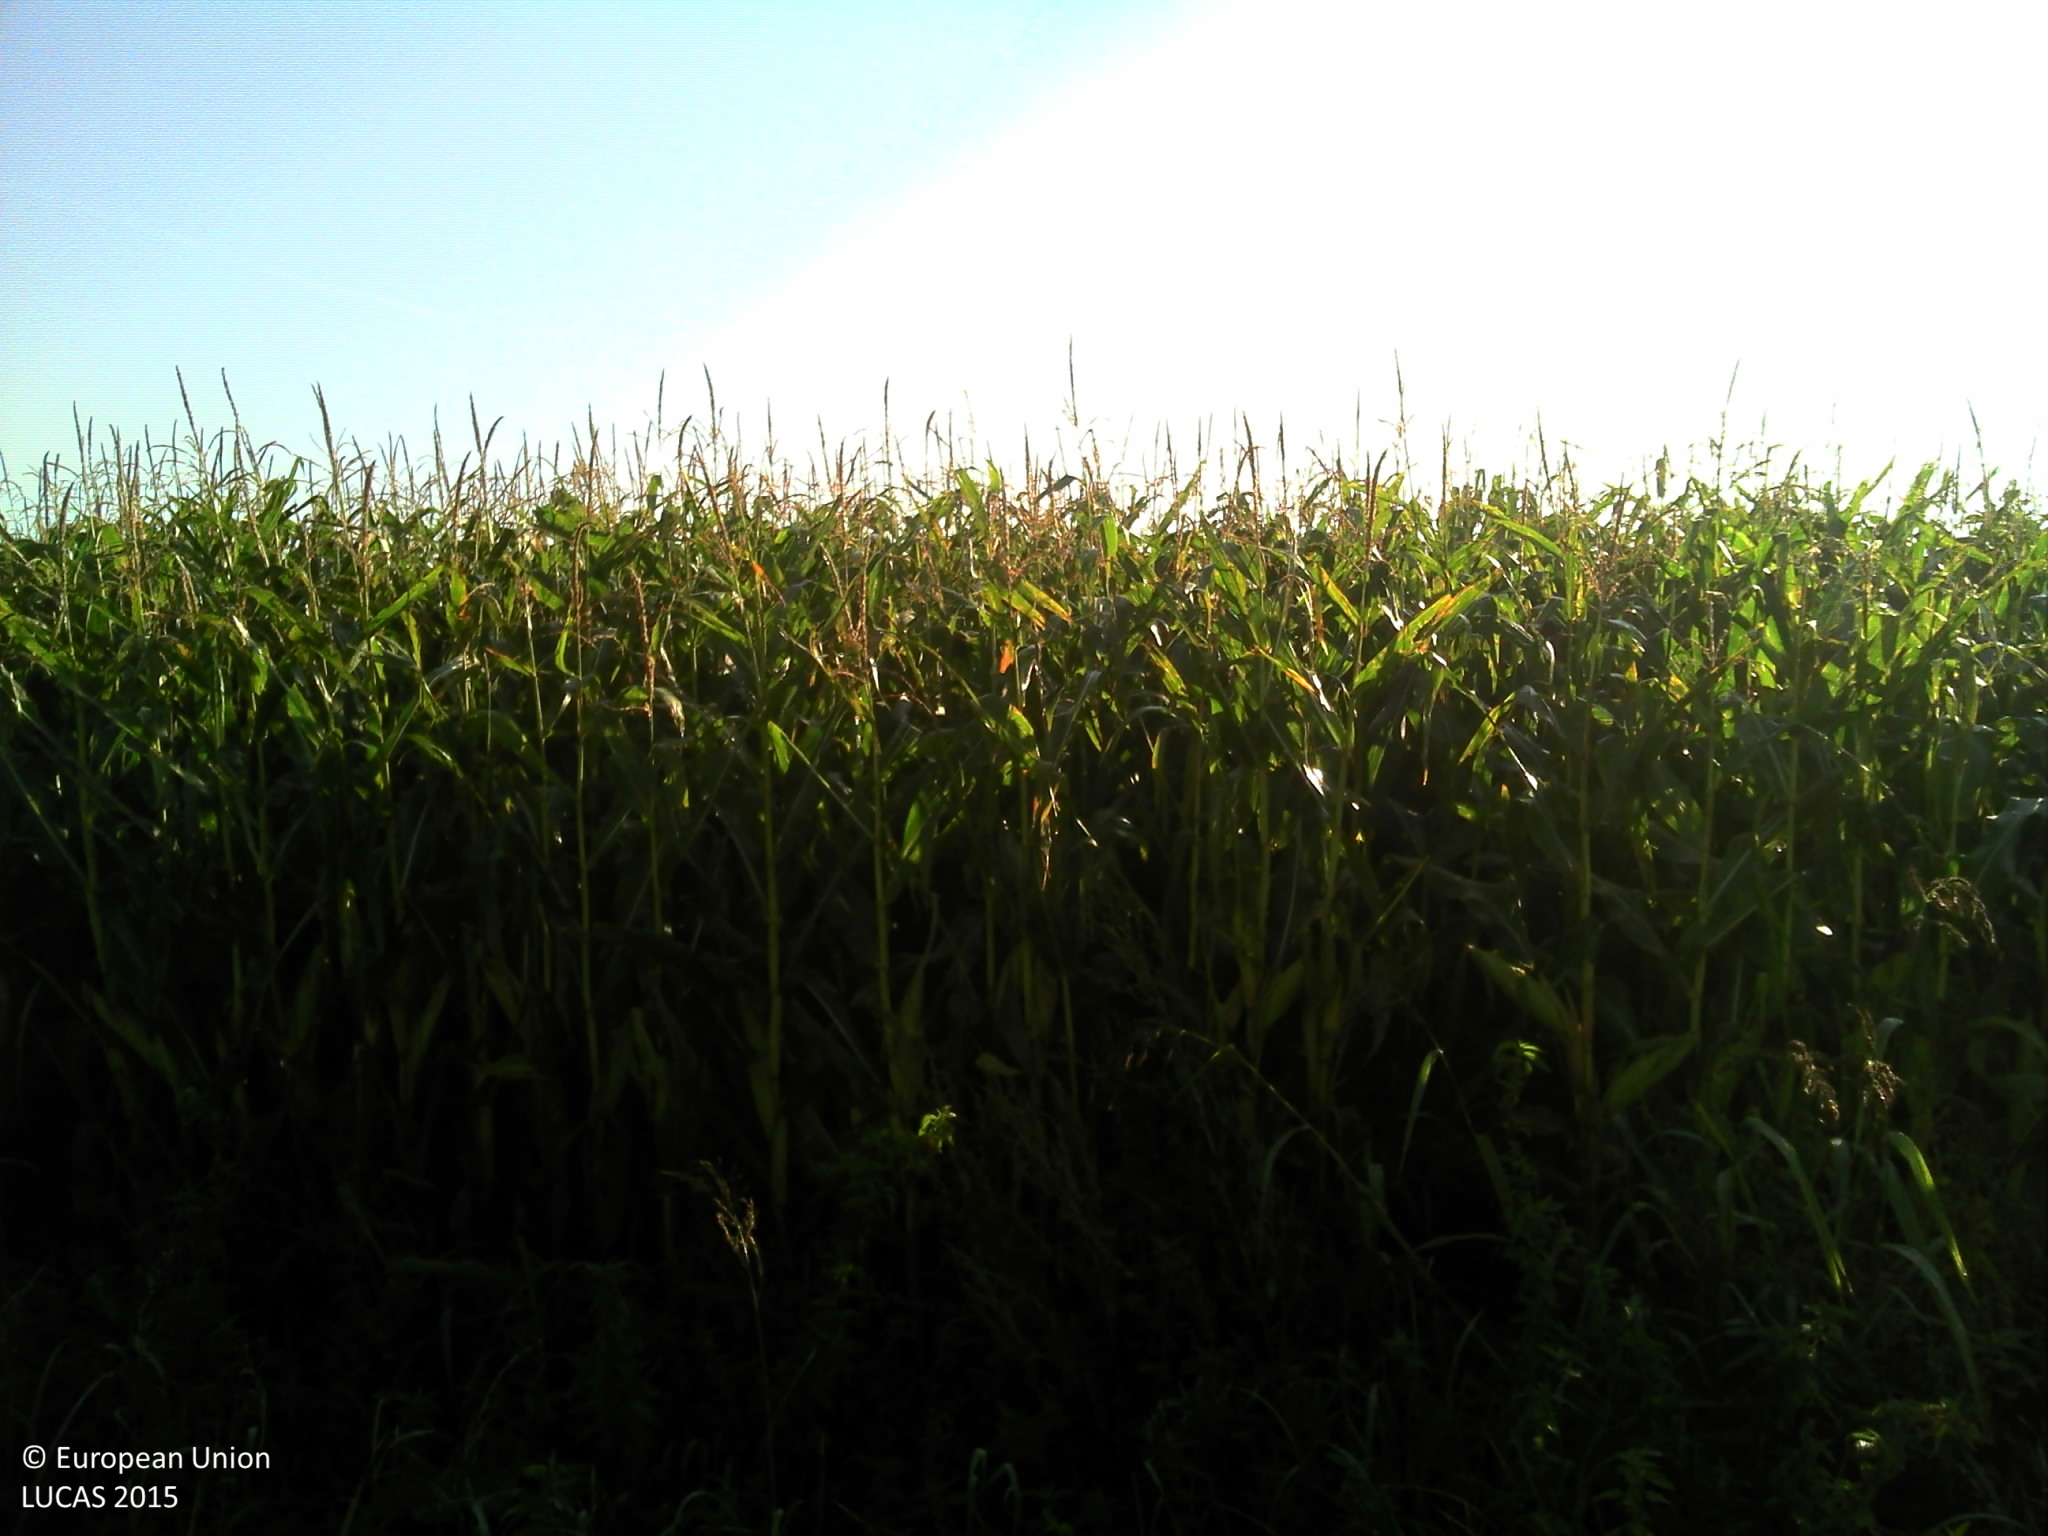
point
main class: Cropland
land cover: Maize
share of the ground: > 75 %
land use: Agriculture (excluding fallow land and kitchen gardens)
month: September
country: BE
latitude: 50.9638
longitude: 2.7411
